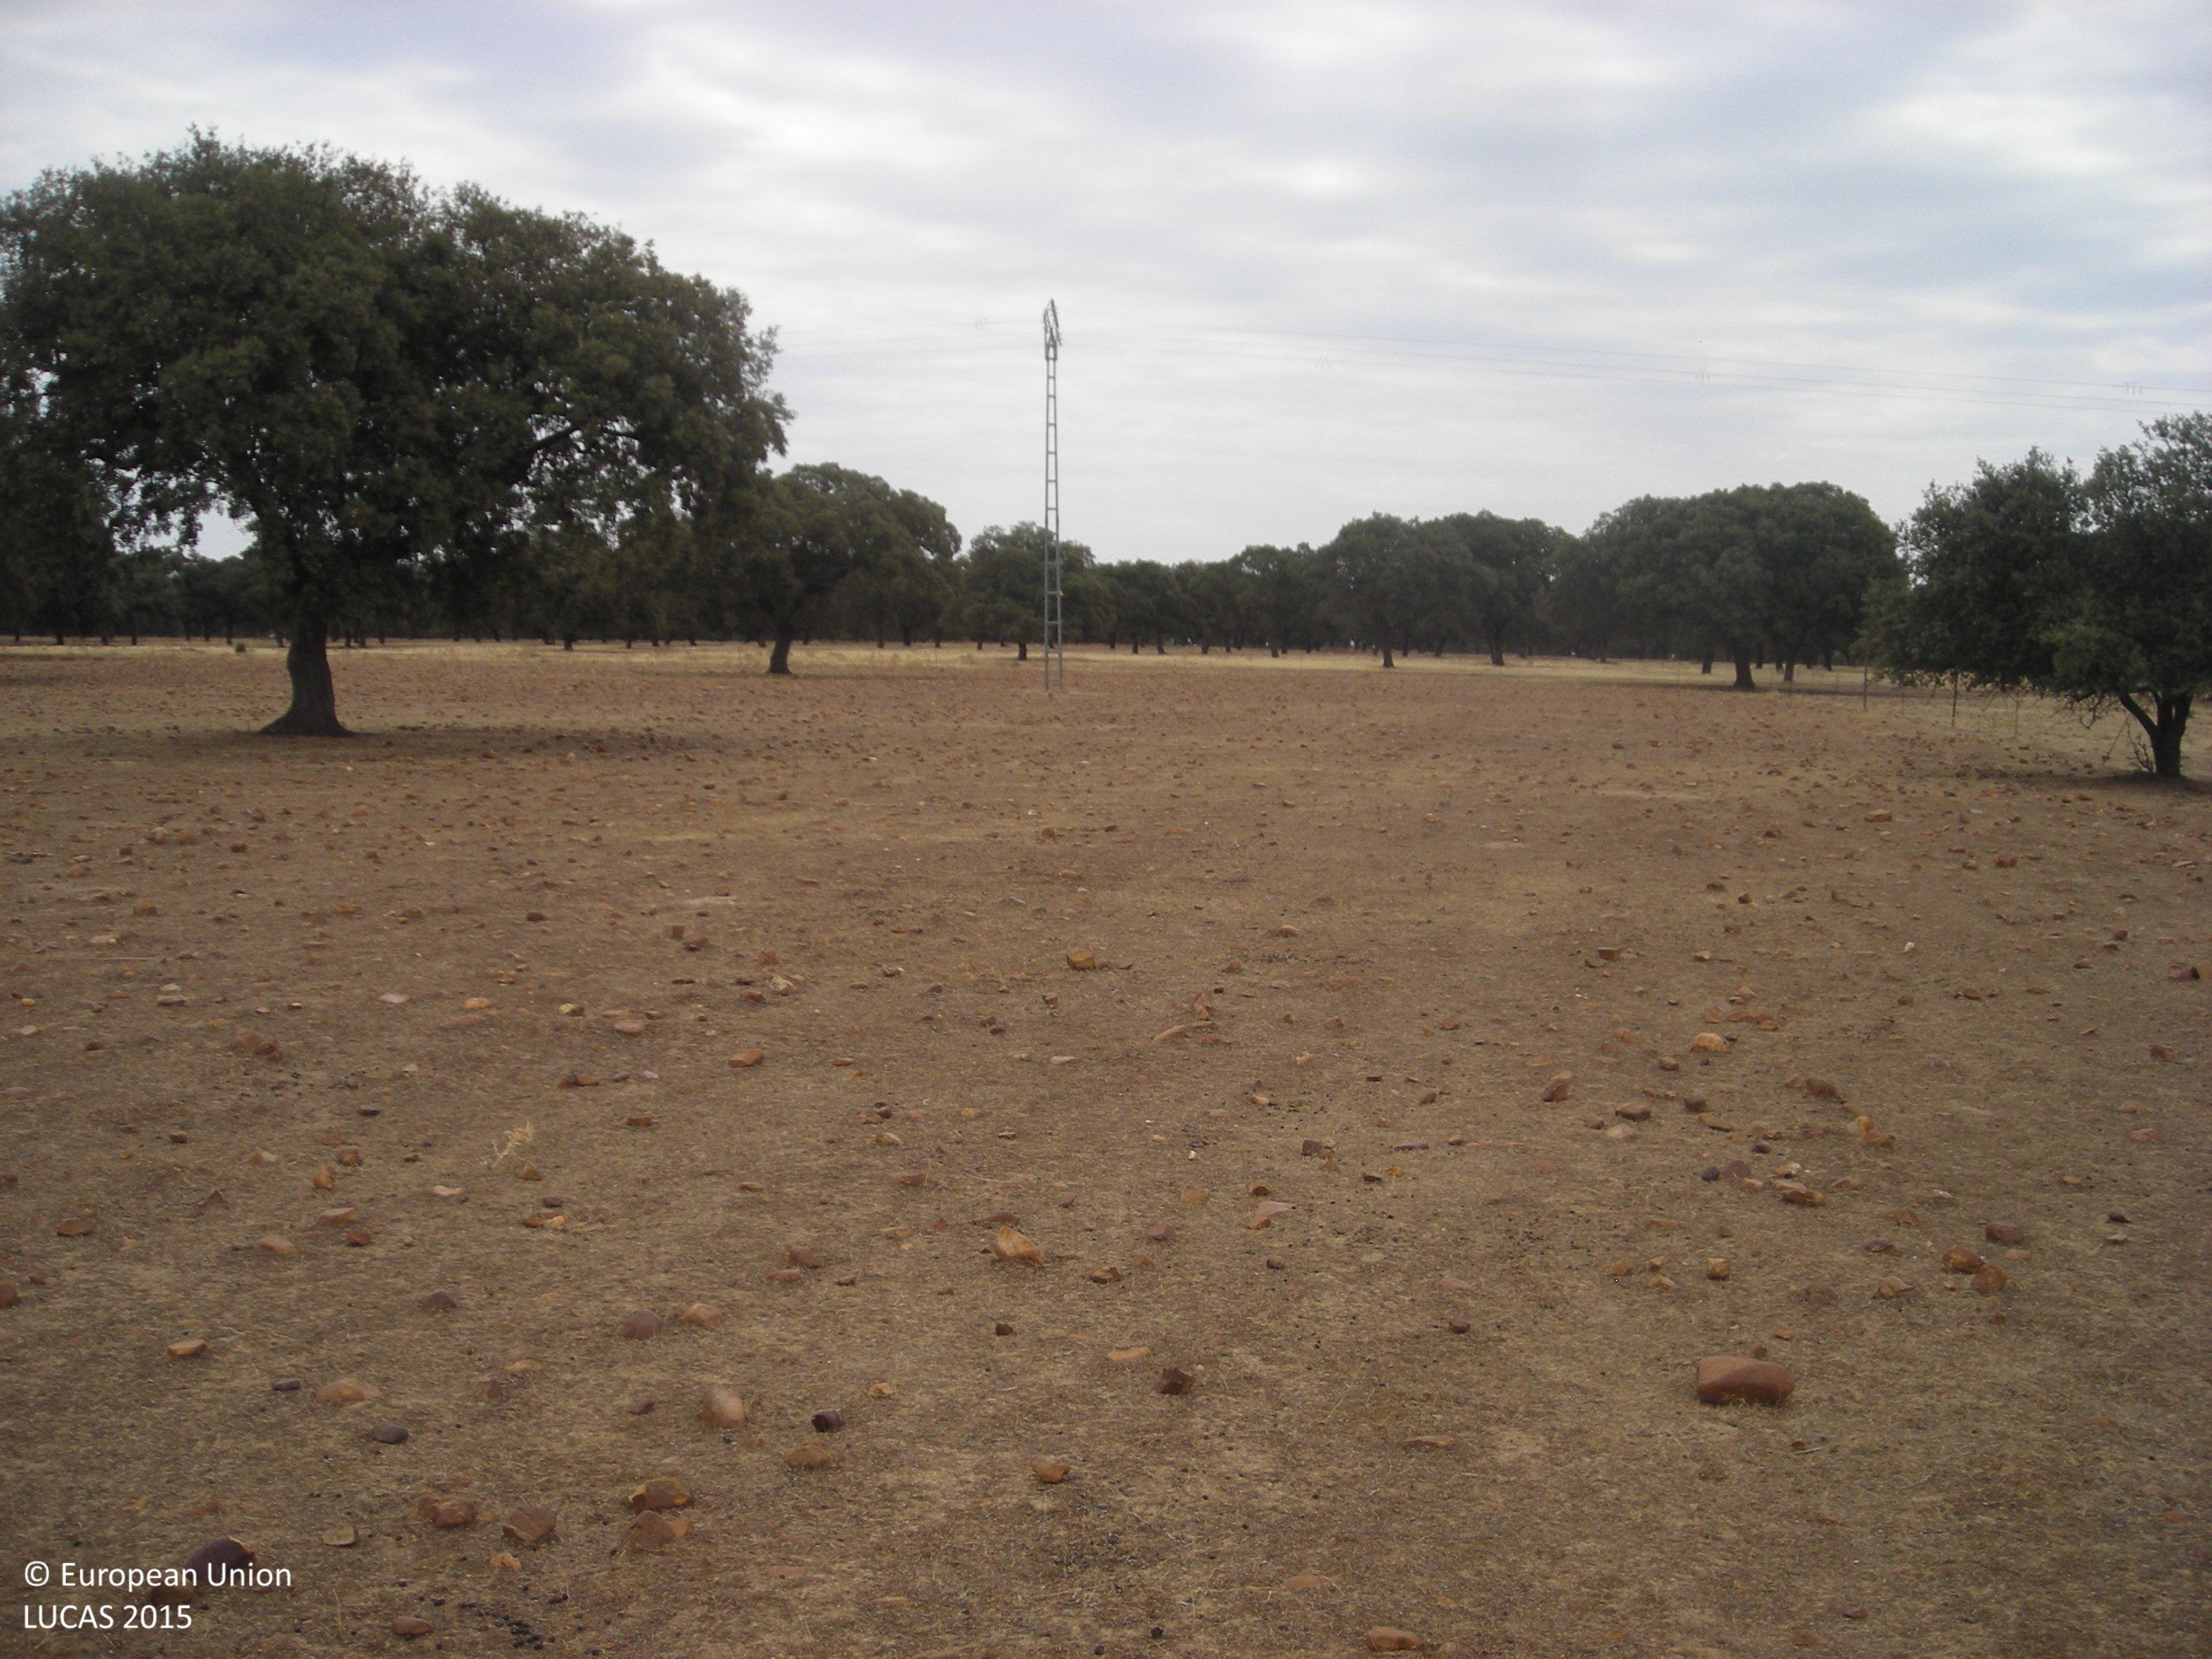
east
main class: Grassland
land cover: Grassland without tree/shrub cover
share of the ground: > 75 %
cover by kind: herbaceous plants 100 %
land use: Agriculture (excluding fallow land and kitchen gardens)
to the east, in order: Grassland without tree/shrub cover; Electric lines; Grassland without tree/shrub cover; Fences; Grass margins; Ditches and canals; Tracks; Ditches and canals; Broadleaved woodland
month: July
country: ES
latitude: 39.1743
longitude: -5.4994
